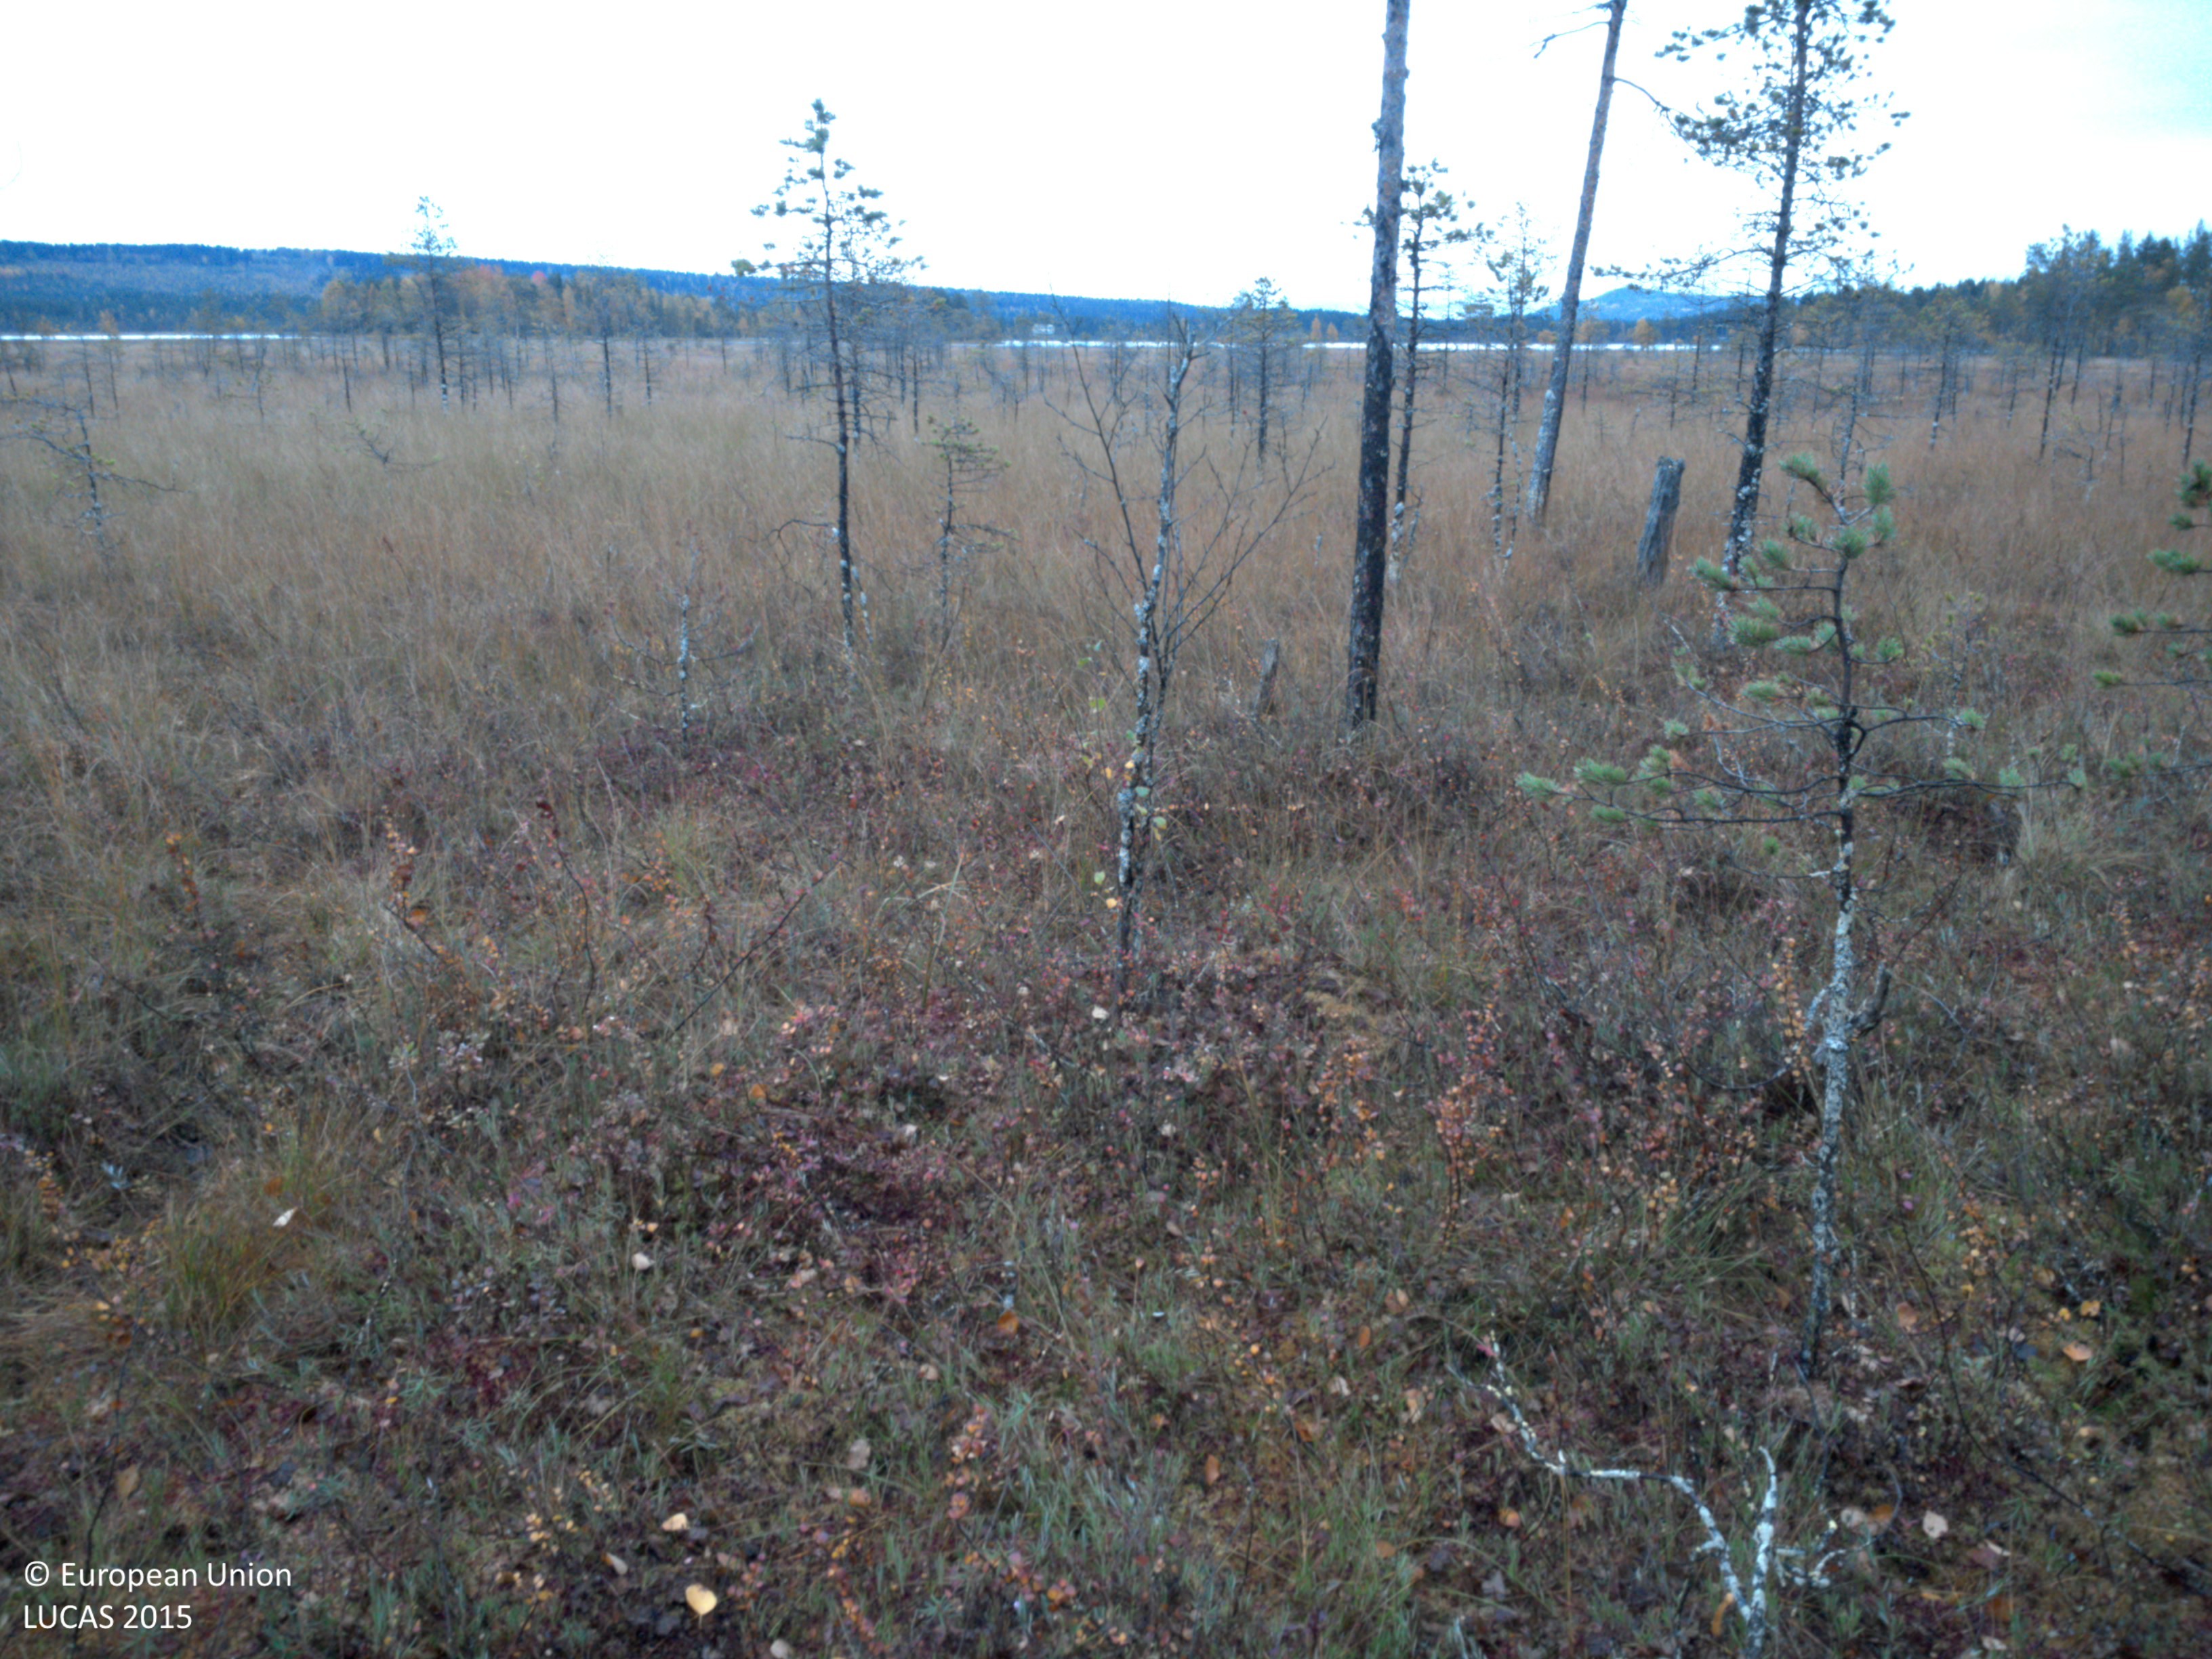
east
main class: Woodland
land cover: Pine dominated coniferous woodland
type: boreal forest
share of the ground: 25 - 50 %
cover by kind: shrubs 30 %, coniferous forest trees 25 %, herbaceous plants 20 %, lichens and mosses 20 %, broadleaved forest trees 5 %
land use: Forestry
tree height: < 5 m
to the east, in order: Pine dominated coniferous woodland; Peatbogs; Ponds and wetlands; Peatbogs; Pine dominated coniferous woodland; Peatbogs
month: September
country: SE
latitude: 65.0013
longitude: 18.9361
